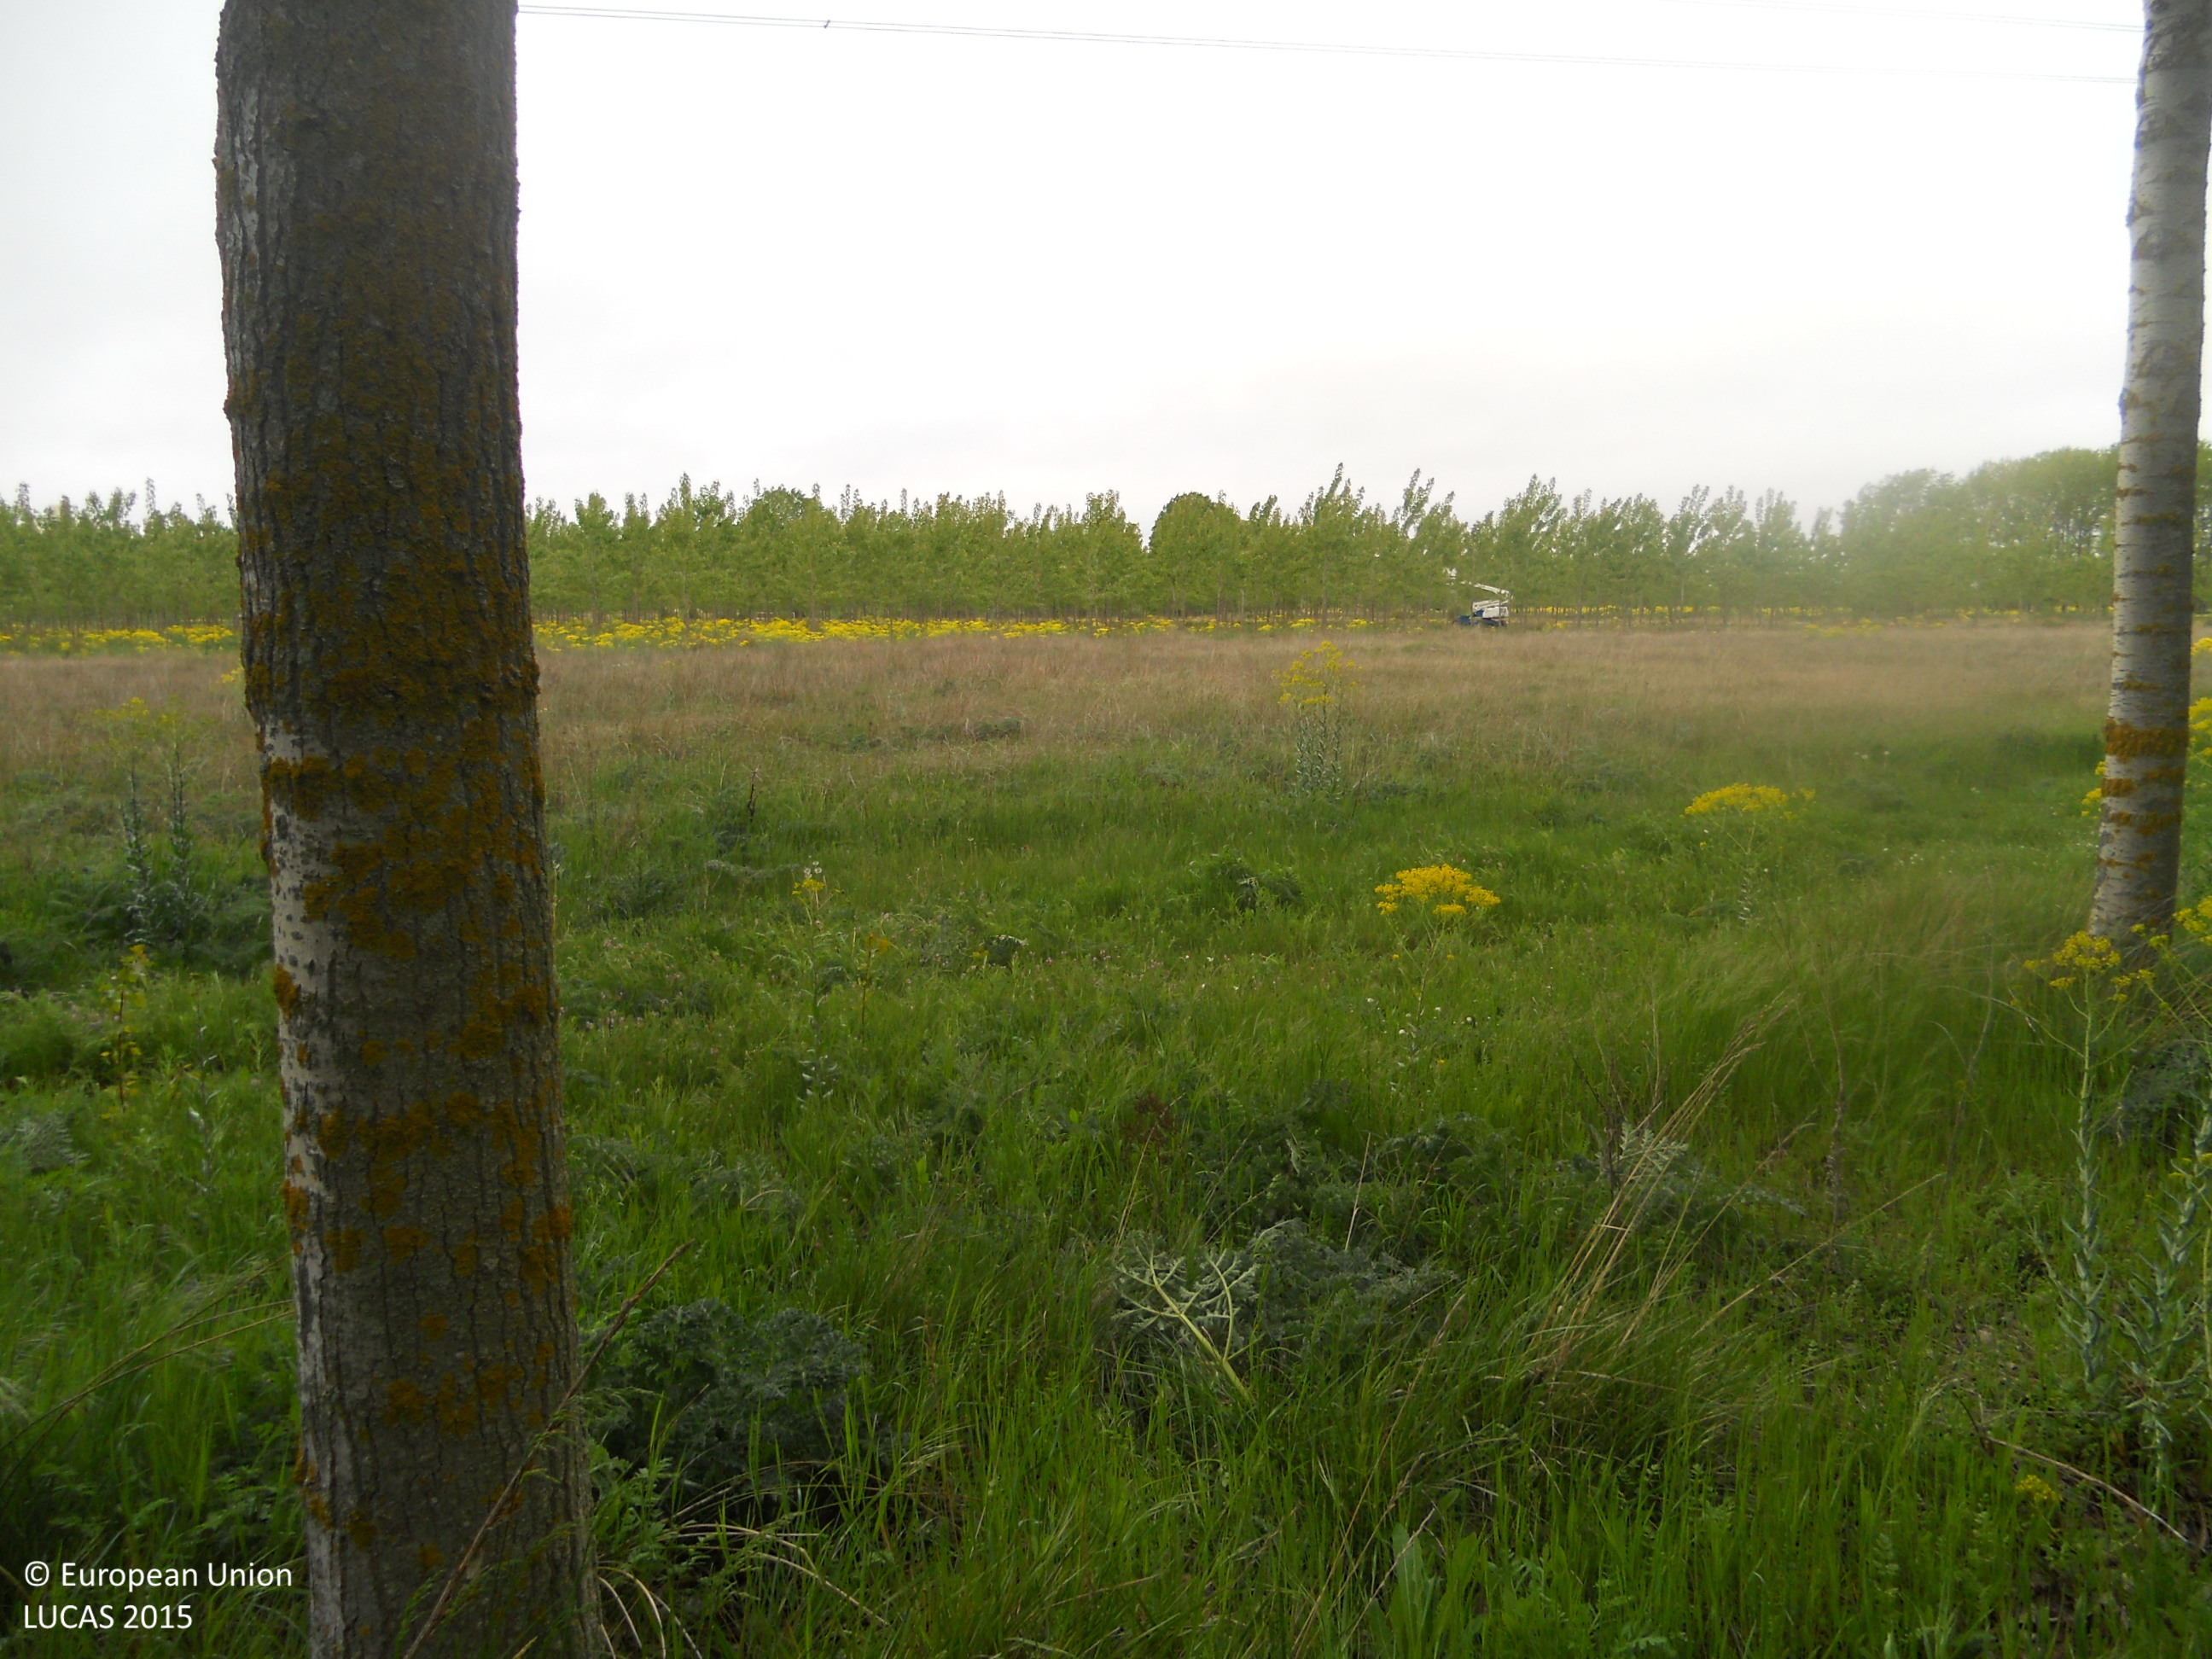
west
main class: Woodland
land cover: Broadleaved woodland
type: floodplain forest
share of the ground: > 75 %
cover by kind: broadleaved forest trees 100 %
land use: Forestry
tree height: > 5 m
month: May
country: ES
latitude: 42.4624
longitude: -5.3782
